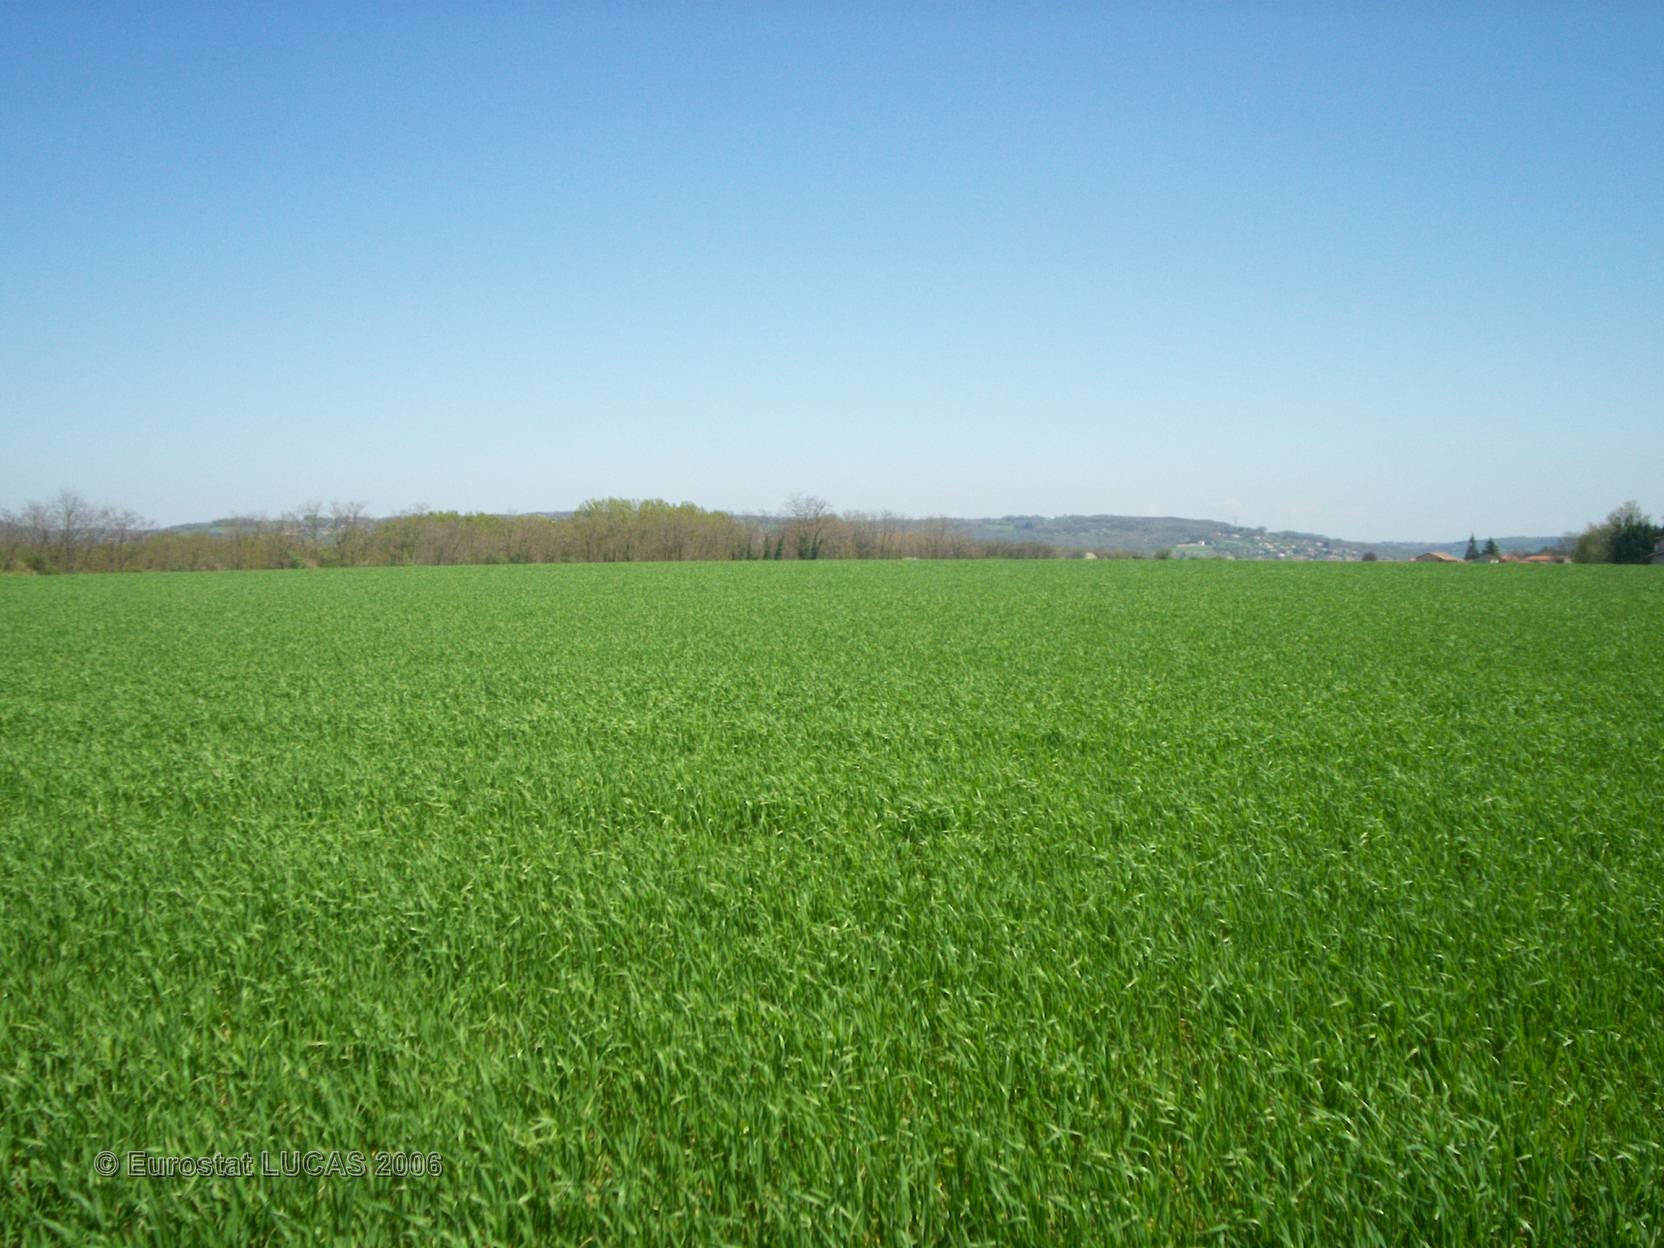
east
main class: Cropland
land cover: Common wheat
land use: Agriculture (excluding fallow land and kitchen gardens)
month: April
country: FR
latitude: 45.4318
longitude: 4.8276
